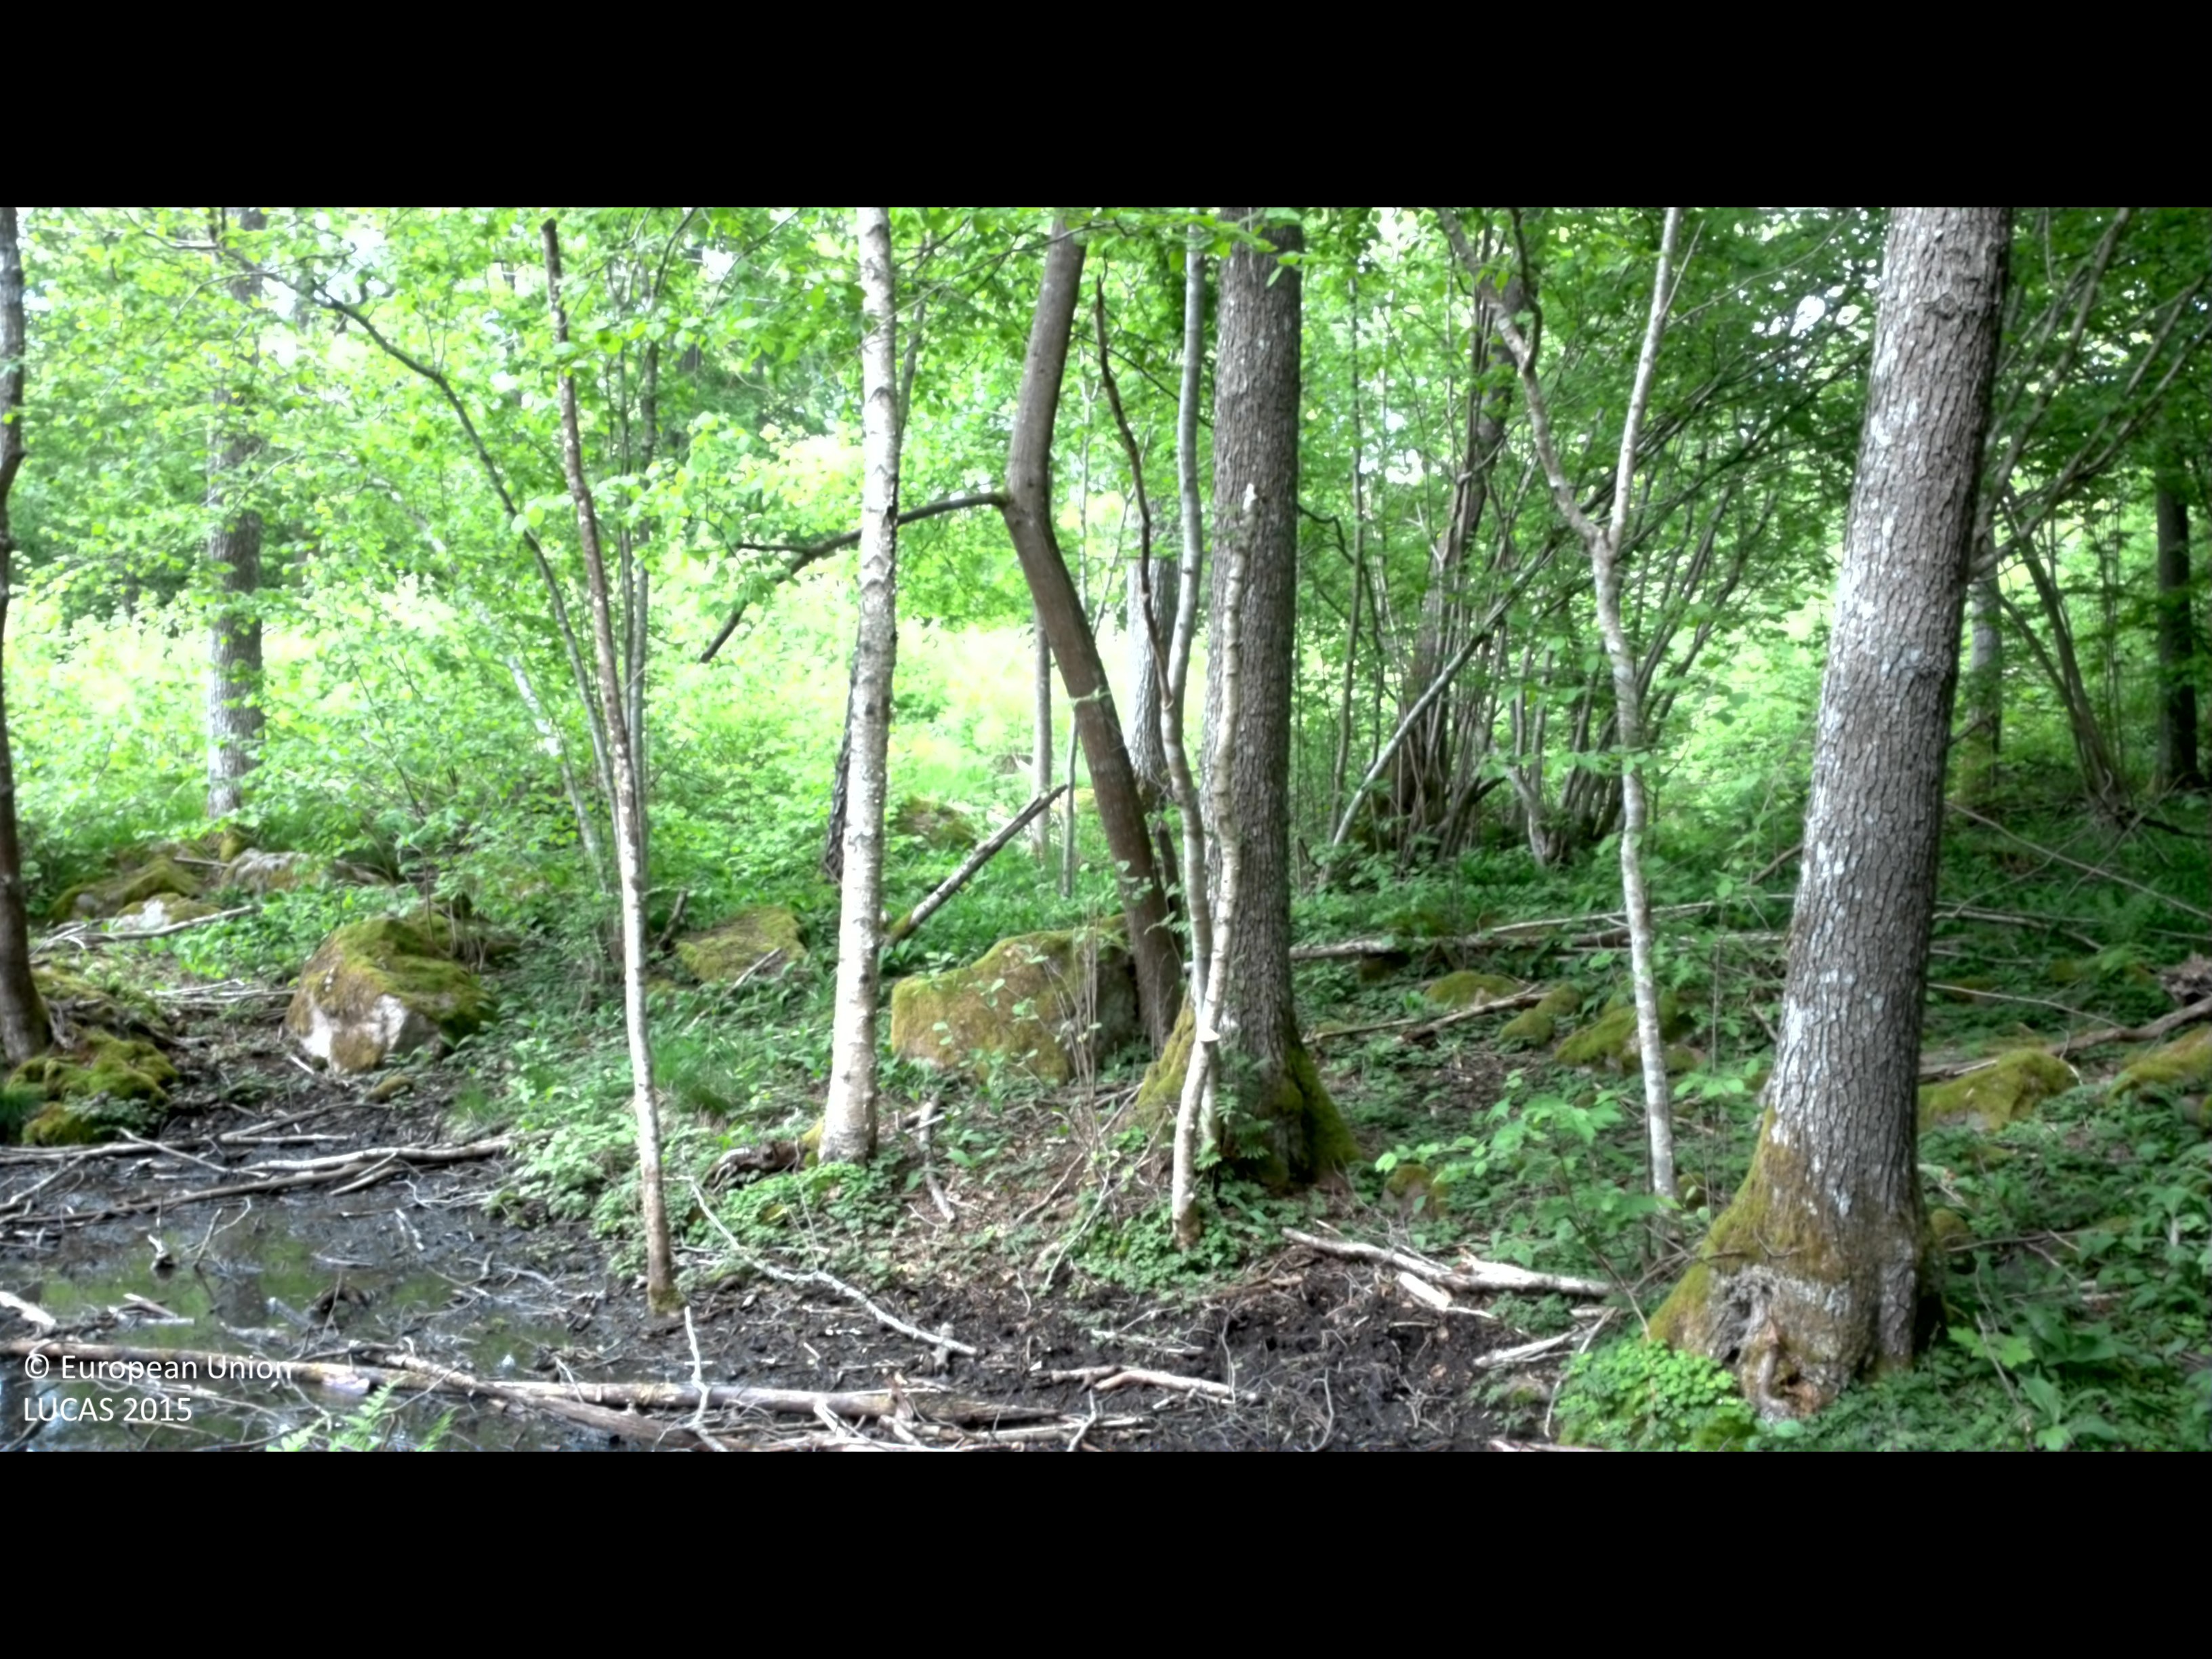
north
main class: Woodland
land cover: Broadleaved woodland
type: hemiboreal forest and nemoral coniferous forest and mixed broadleaved-coniferous forest
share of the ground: > 75 %
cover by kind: broadleaved forest trees 85 %, shrubs 15 %
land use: Forestry
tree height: > 5 m
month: May
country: SE
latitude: 57.3779
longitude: 16.4691
